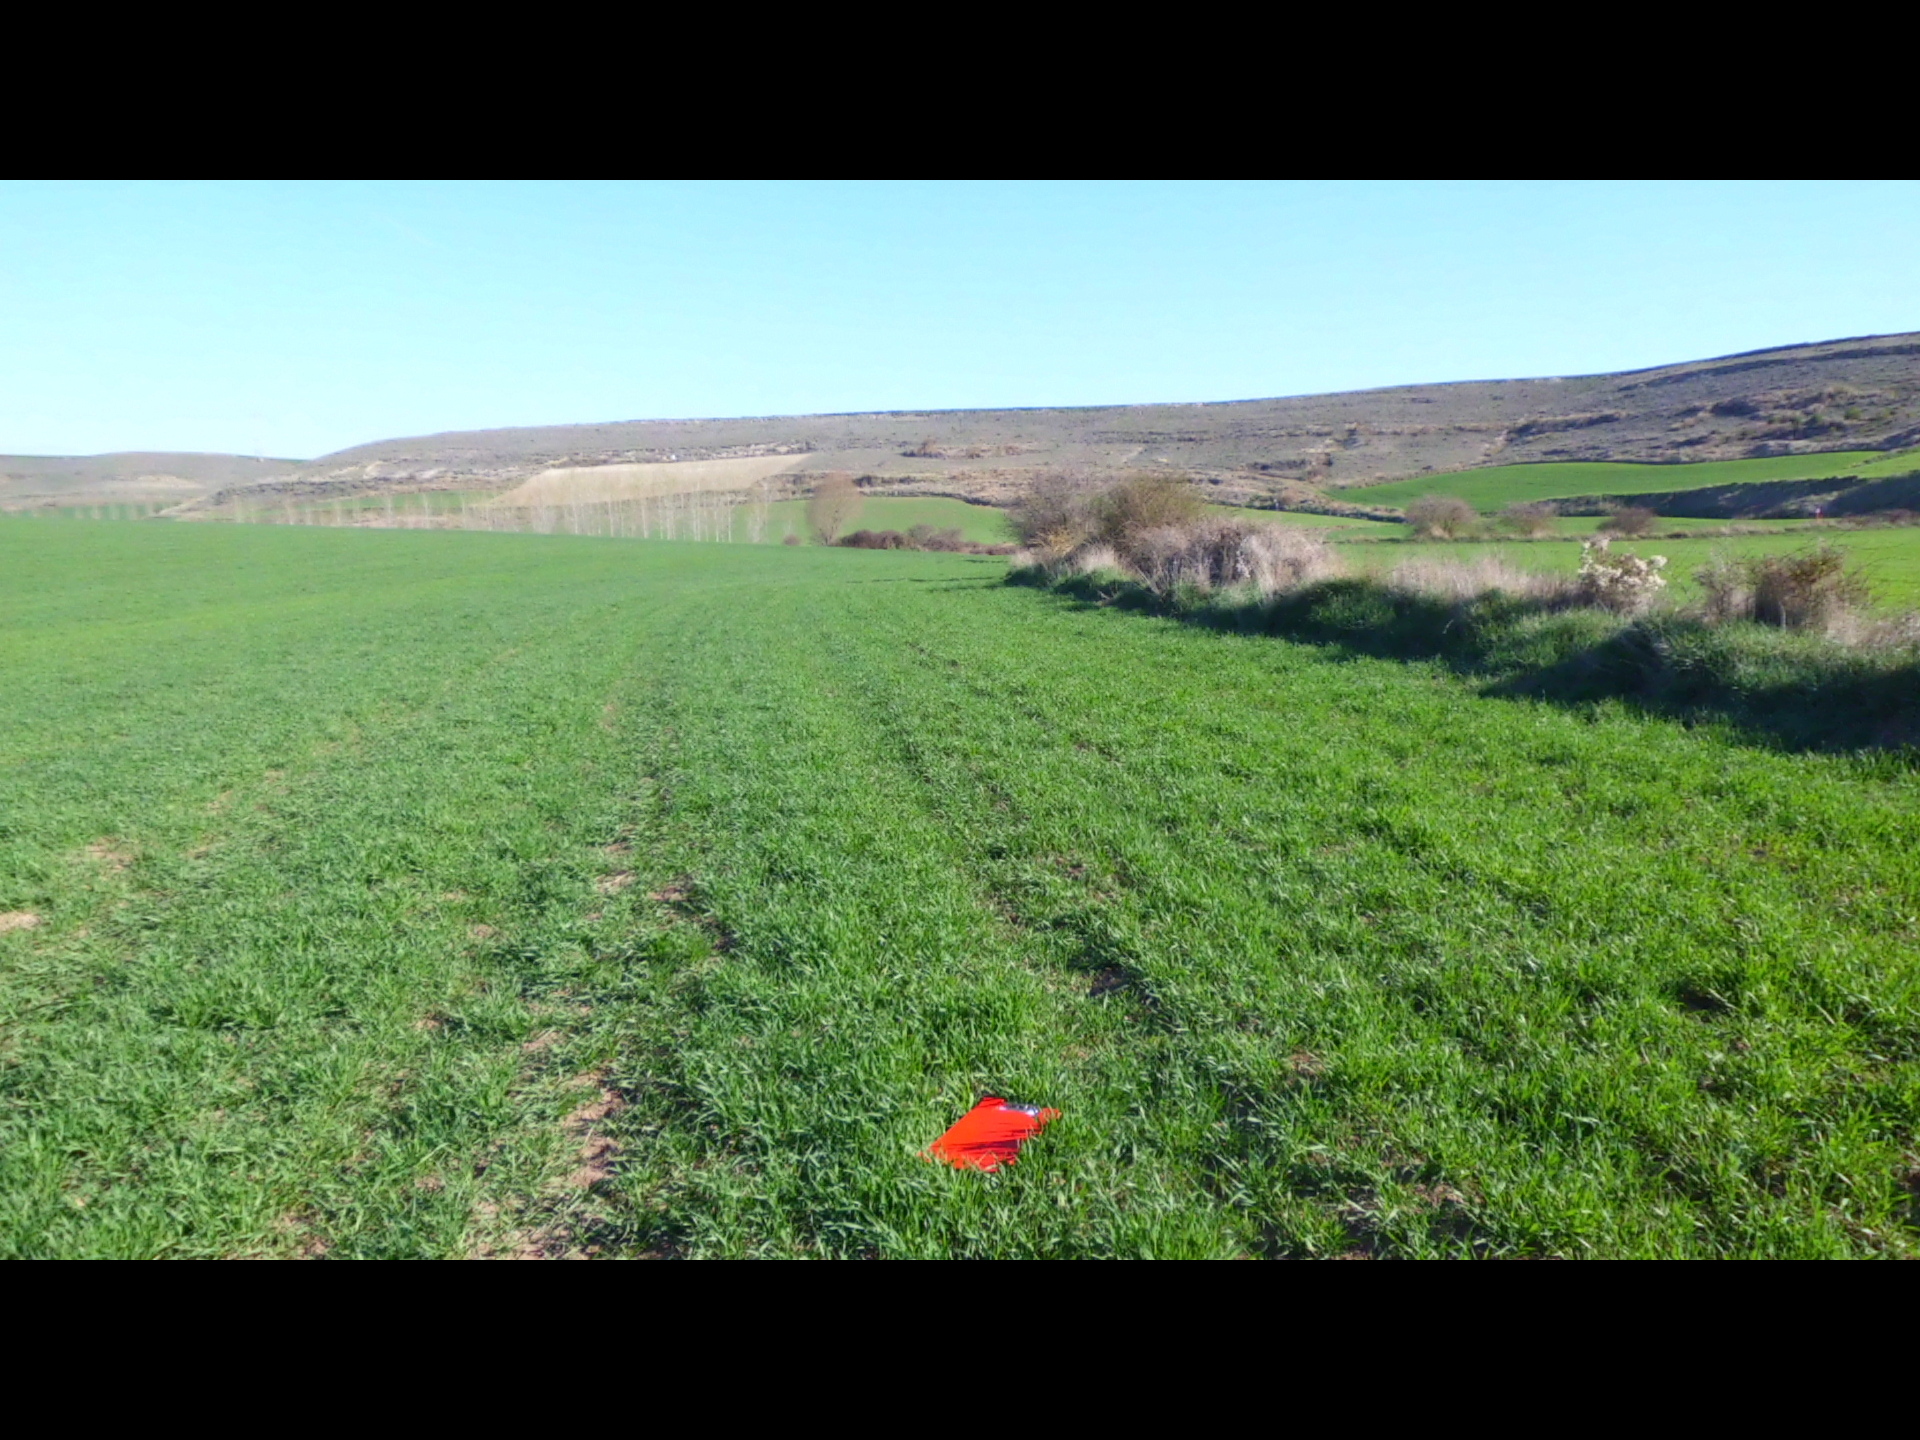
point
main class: Cropland
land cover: Common wheat
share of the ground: > 75 %
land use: Agriculture (excluding fallow land and kitchen gardens)
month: April
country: ES
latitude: 42.2651
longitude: -3.8460
